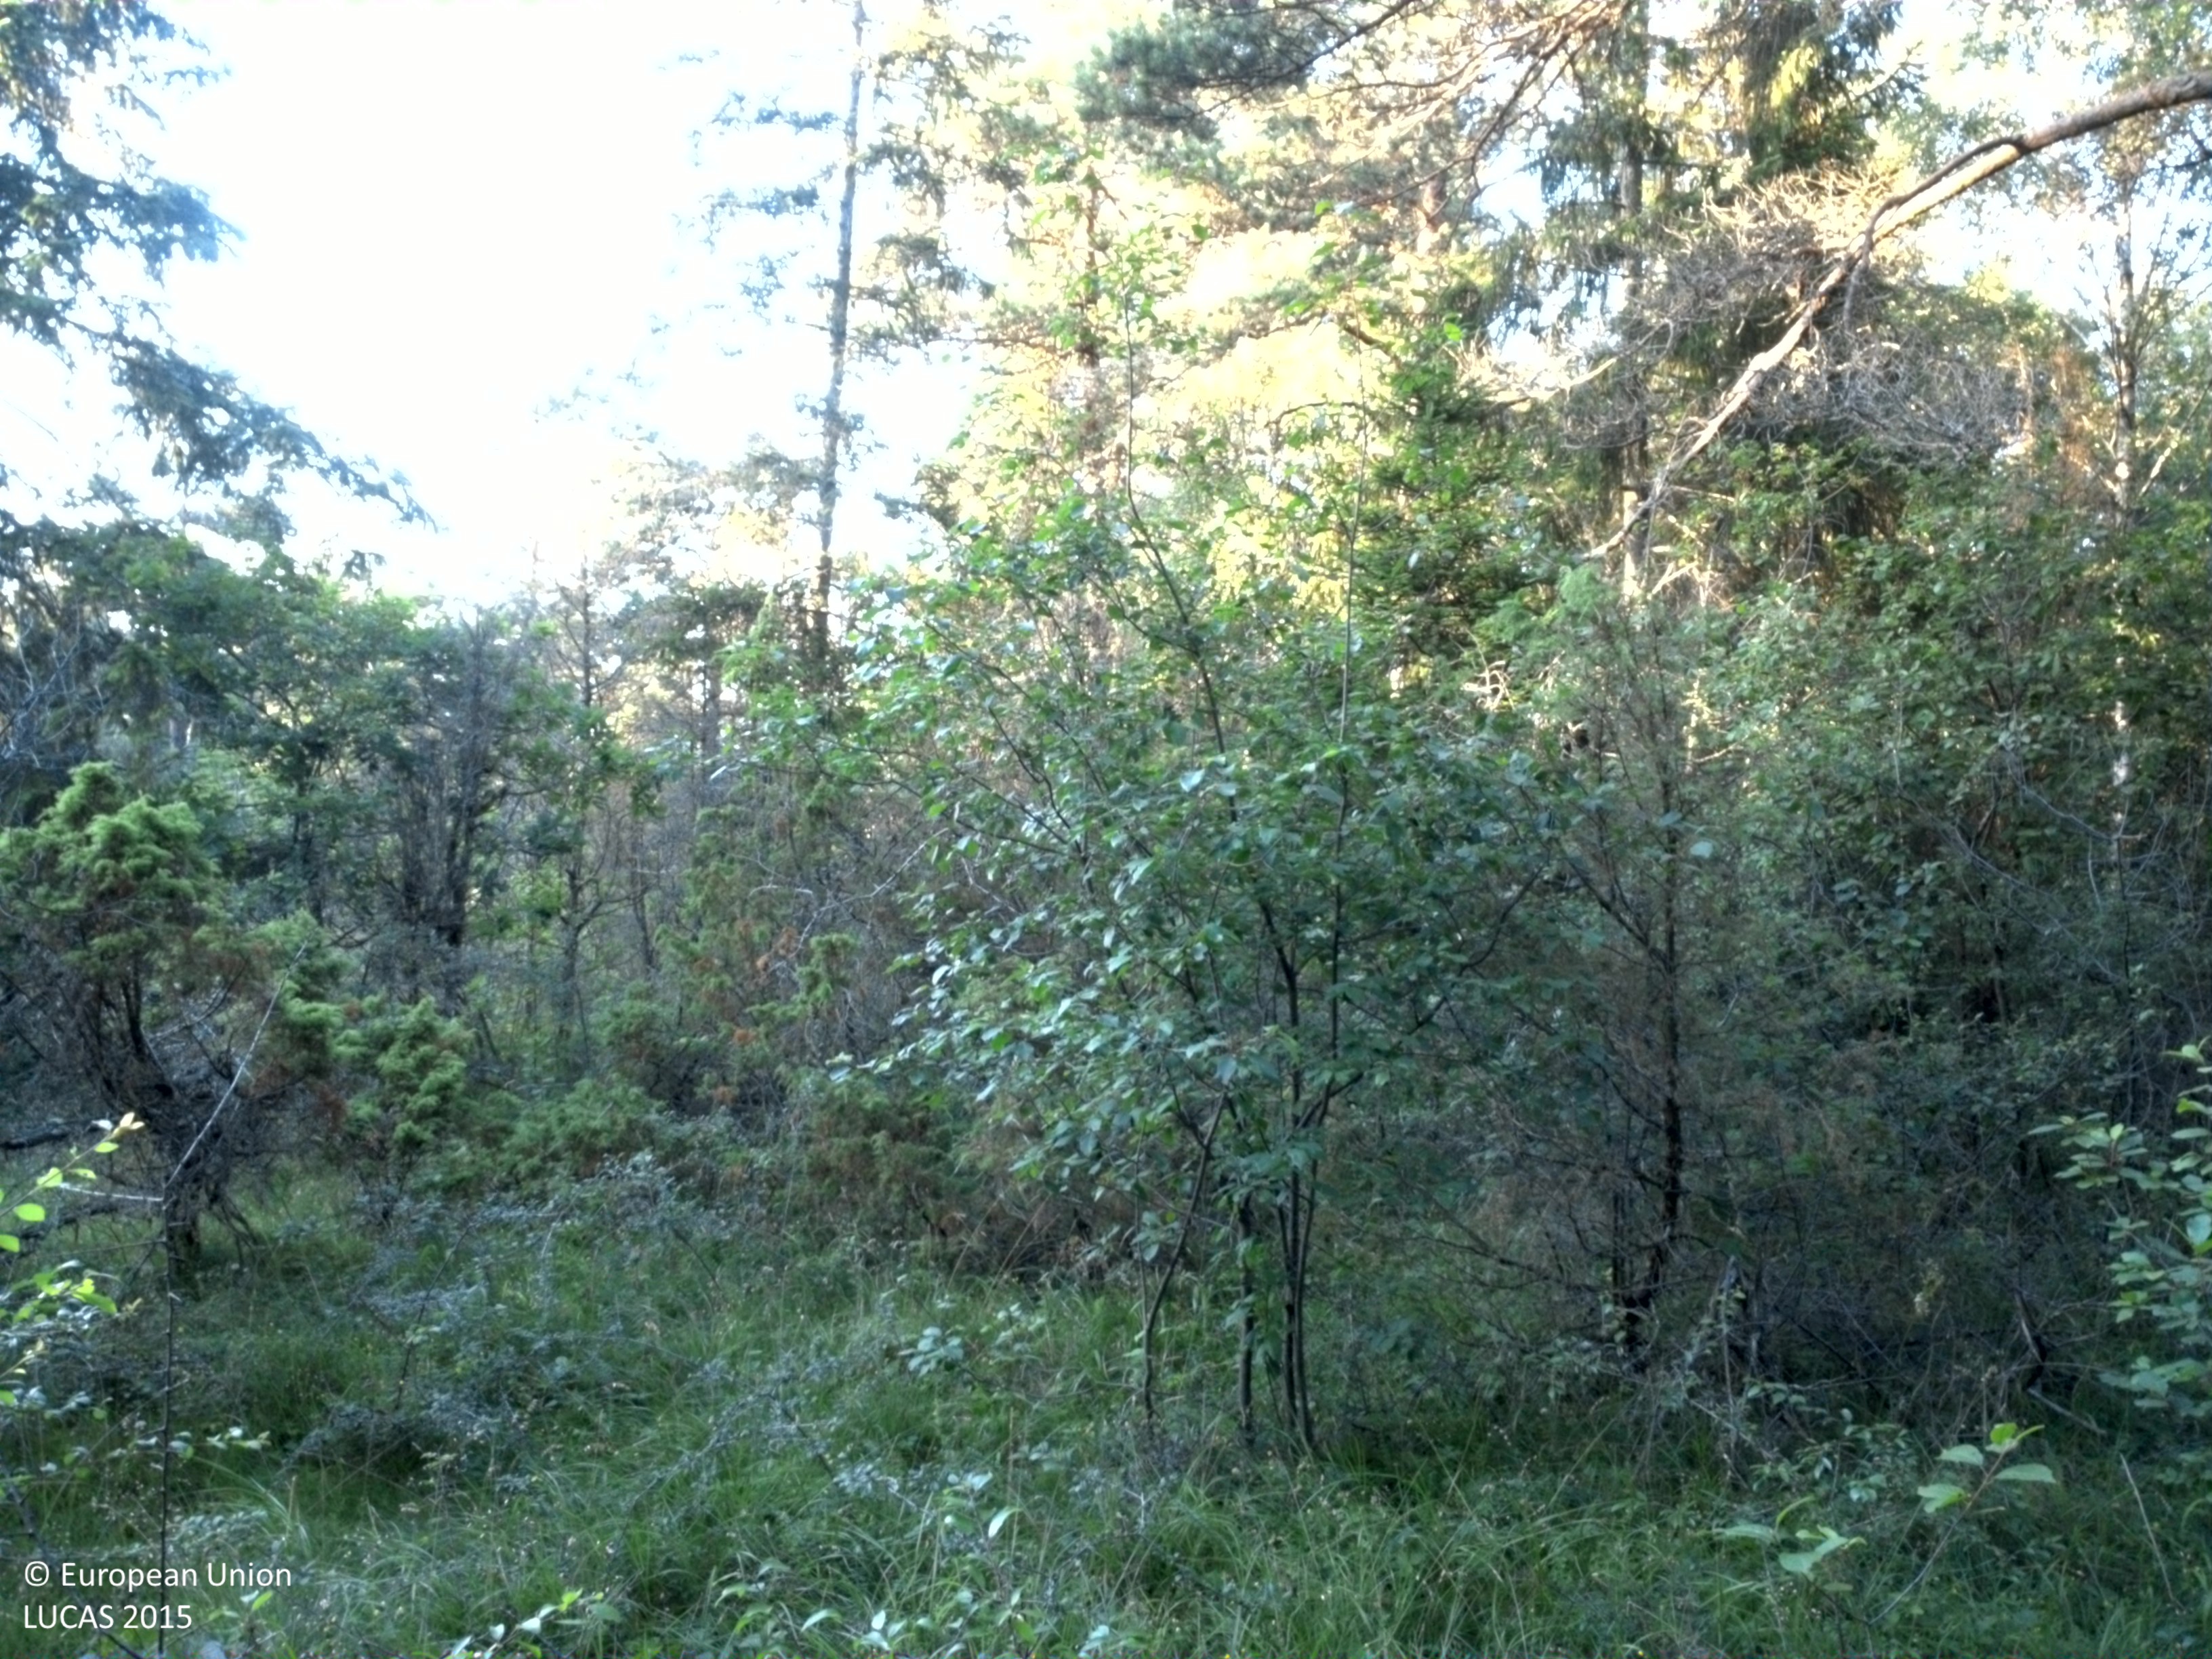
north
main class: Woodland
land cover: Pine dominated coniferous woodland
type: hemiboreal forest and nemoral coniferous forest and mixed broadleaved-coniferous forest
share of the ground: 50 - 75 %
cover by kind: coniferous forest trees 55 %, shrubs 20 %, herbaceous plants 20 %, broadleaved forest trees 5 %
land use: Forestry
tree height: > 5 m
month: July
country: SE
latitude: 57.3191
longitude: 18.4611
